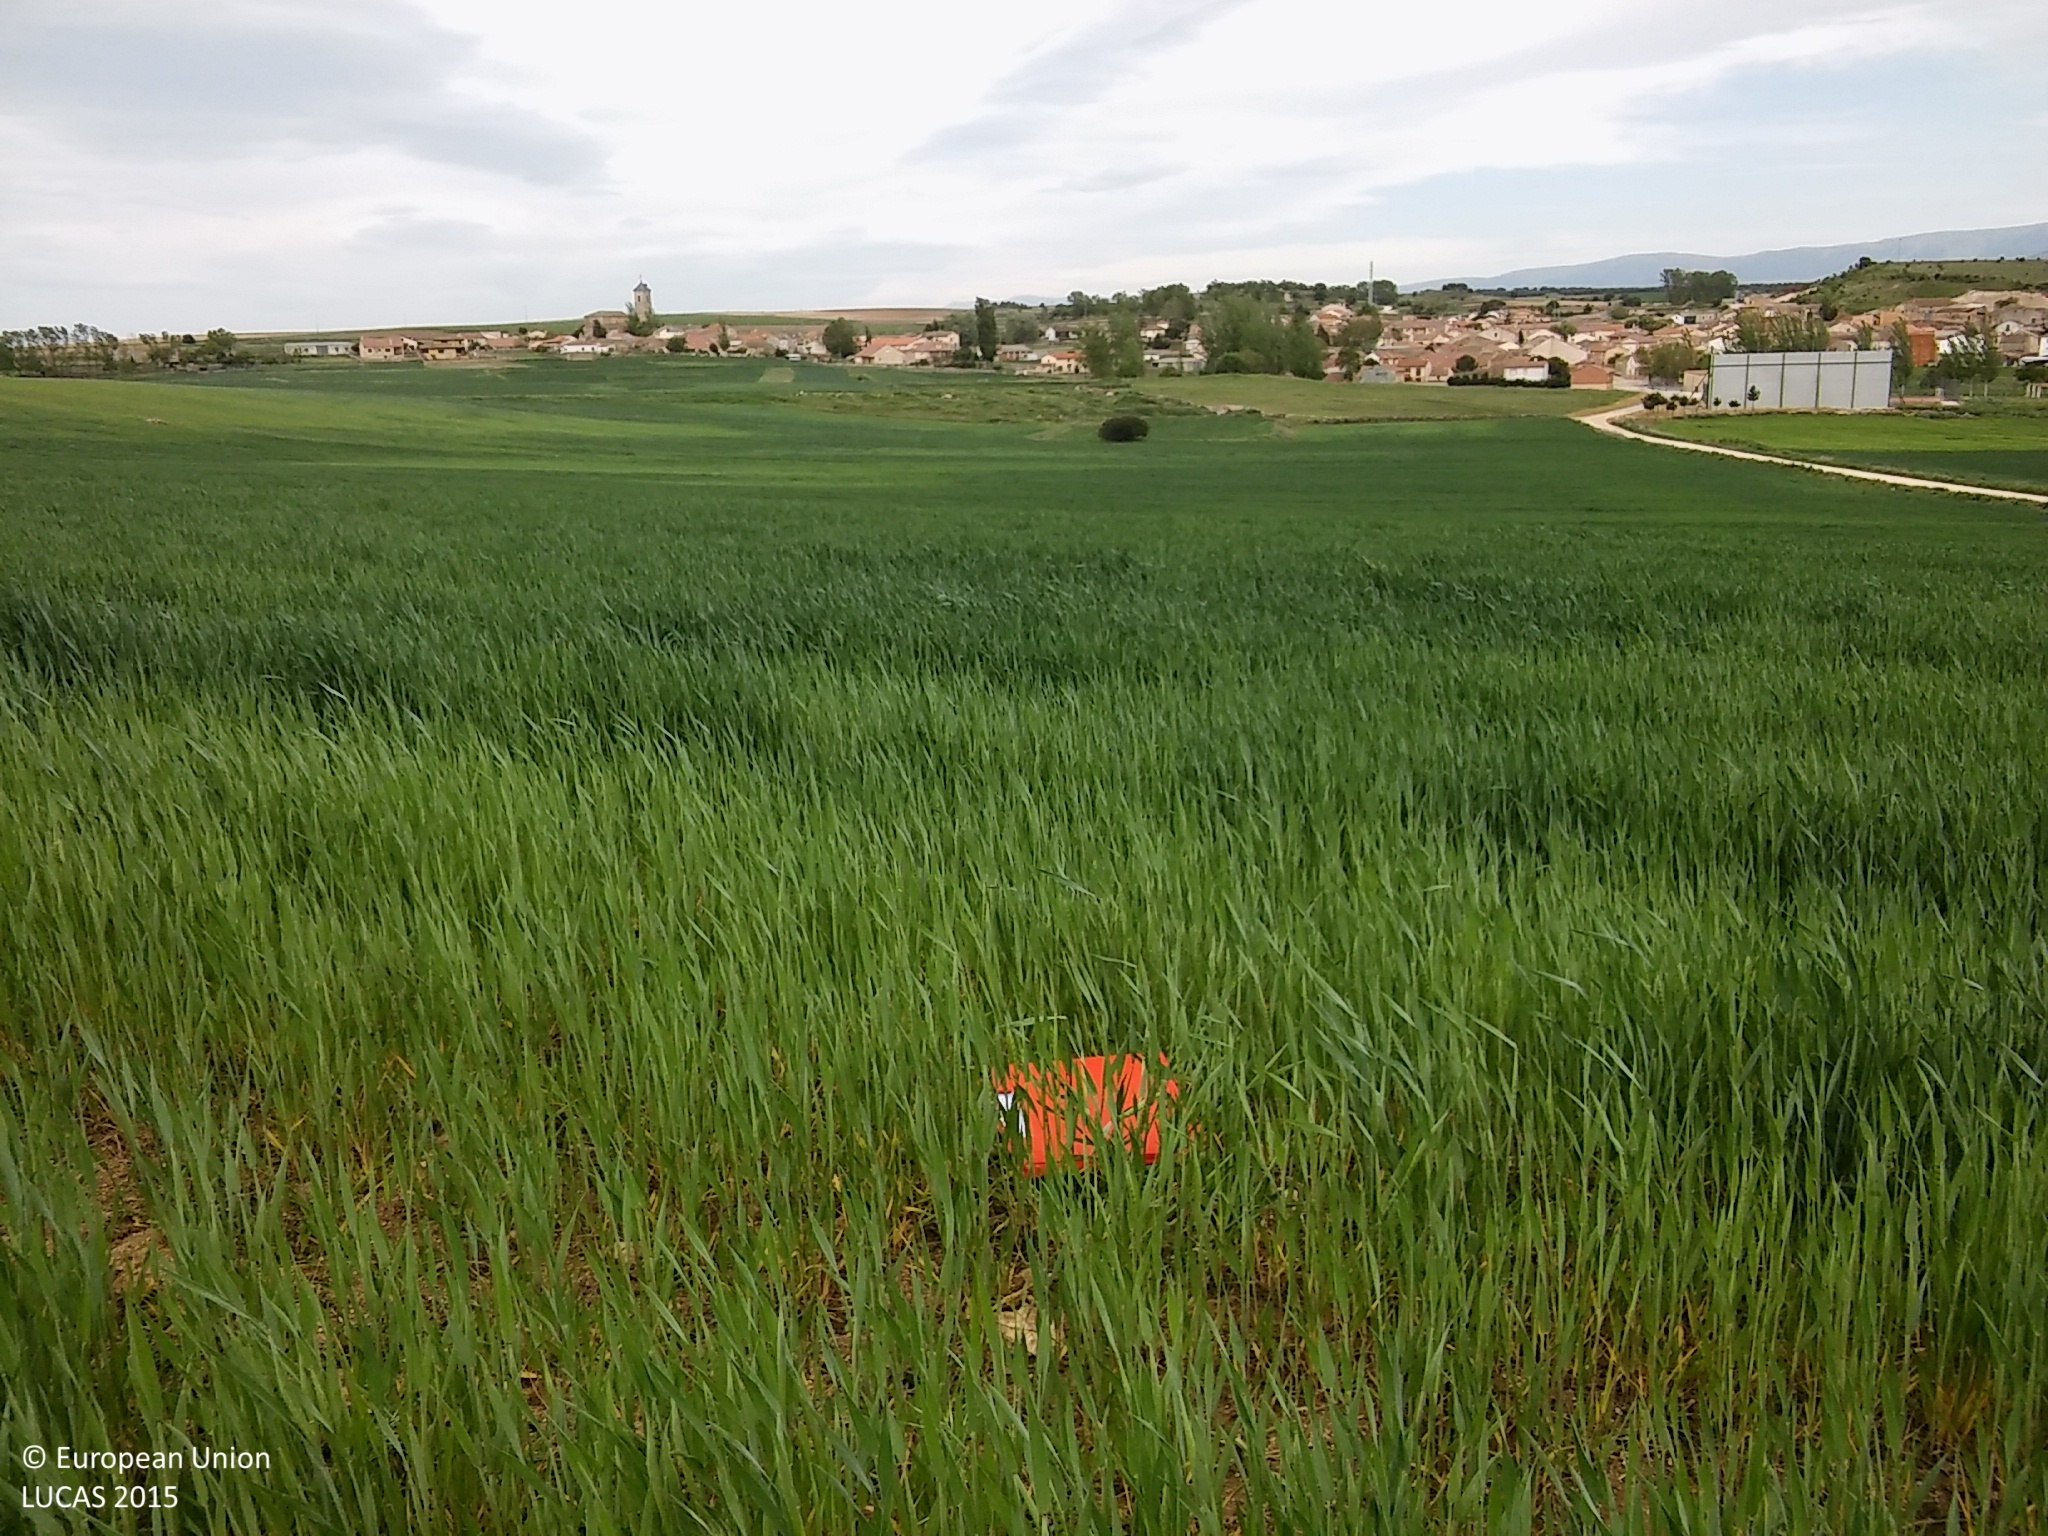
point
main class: Cropland
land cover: Common wheat
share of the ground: > 75 %
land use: Agriculture (excluding fallow land and kitchen gardens)
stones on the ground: < 10 %
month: May
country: ES
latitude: 41.1028
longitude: -4.0418
